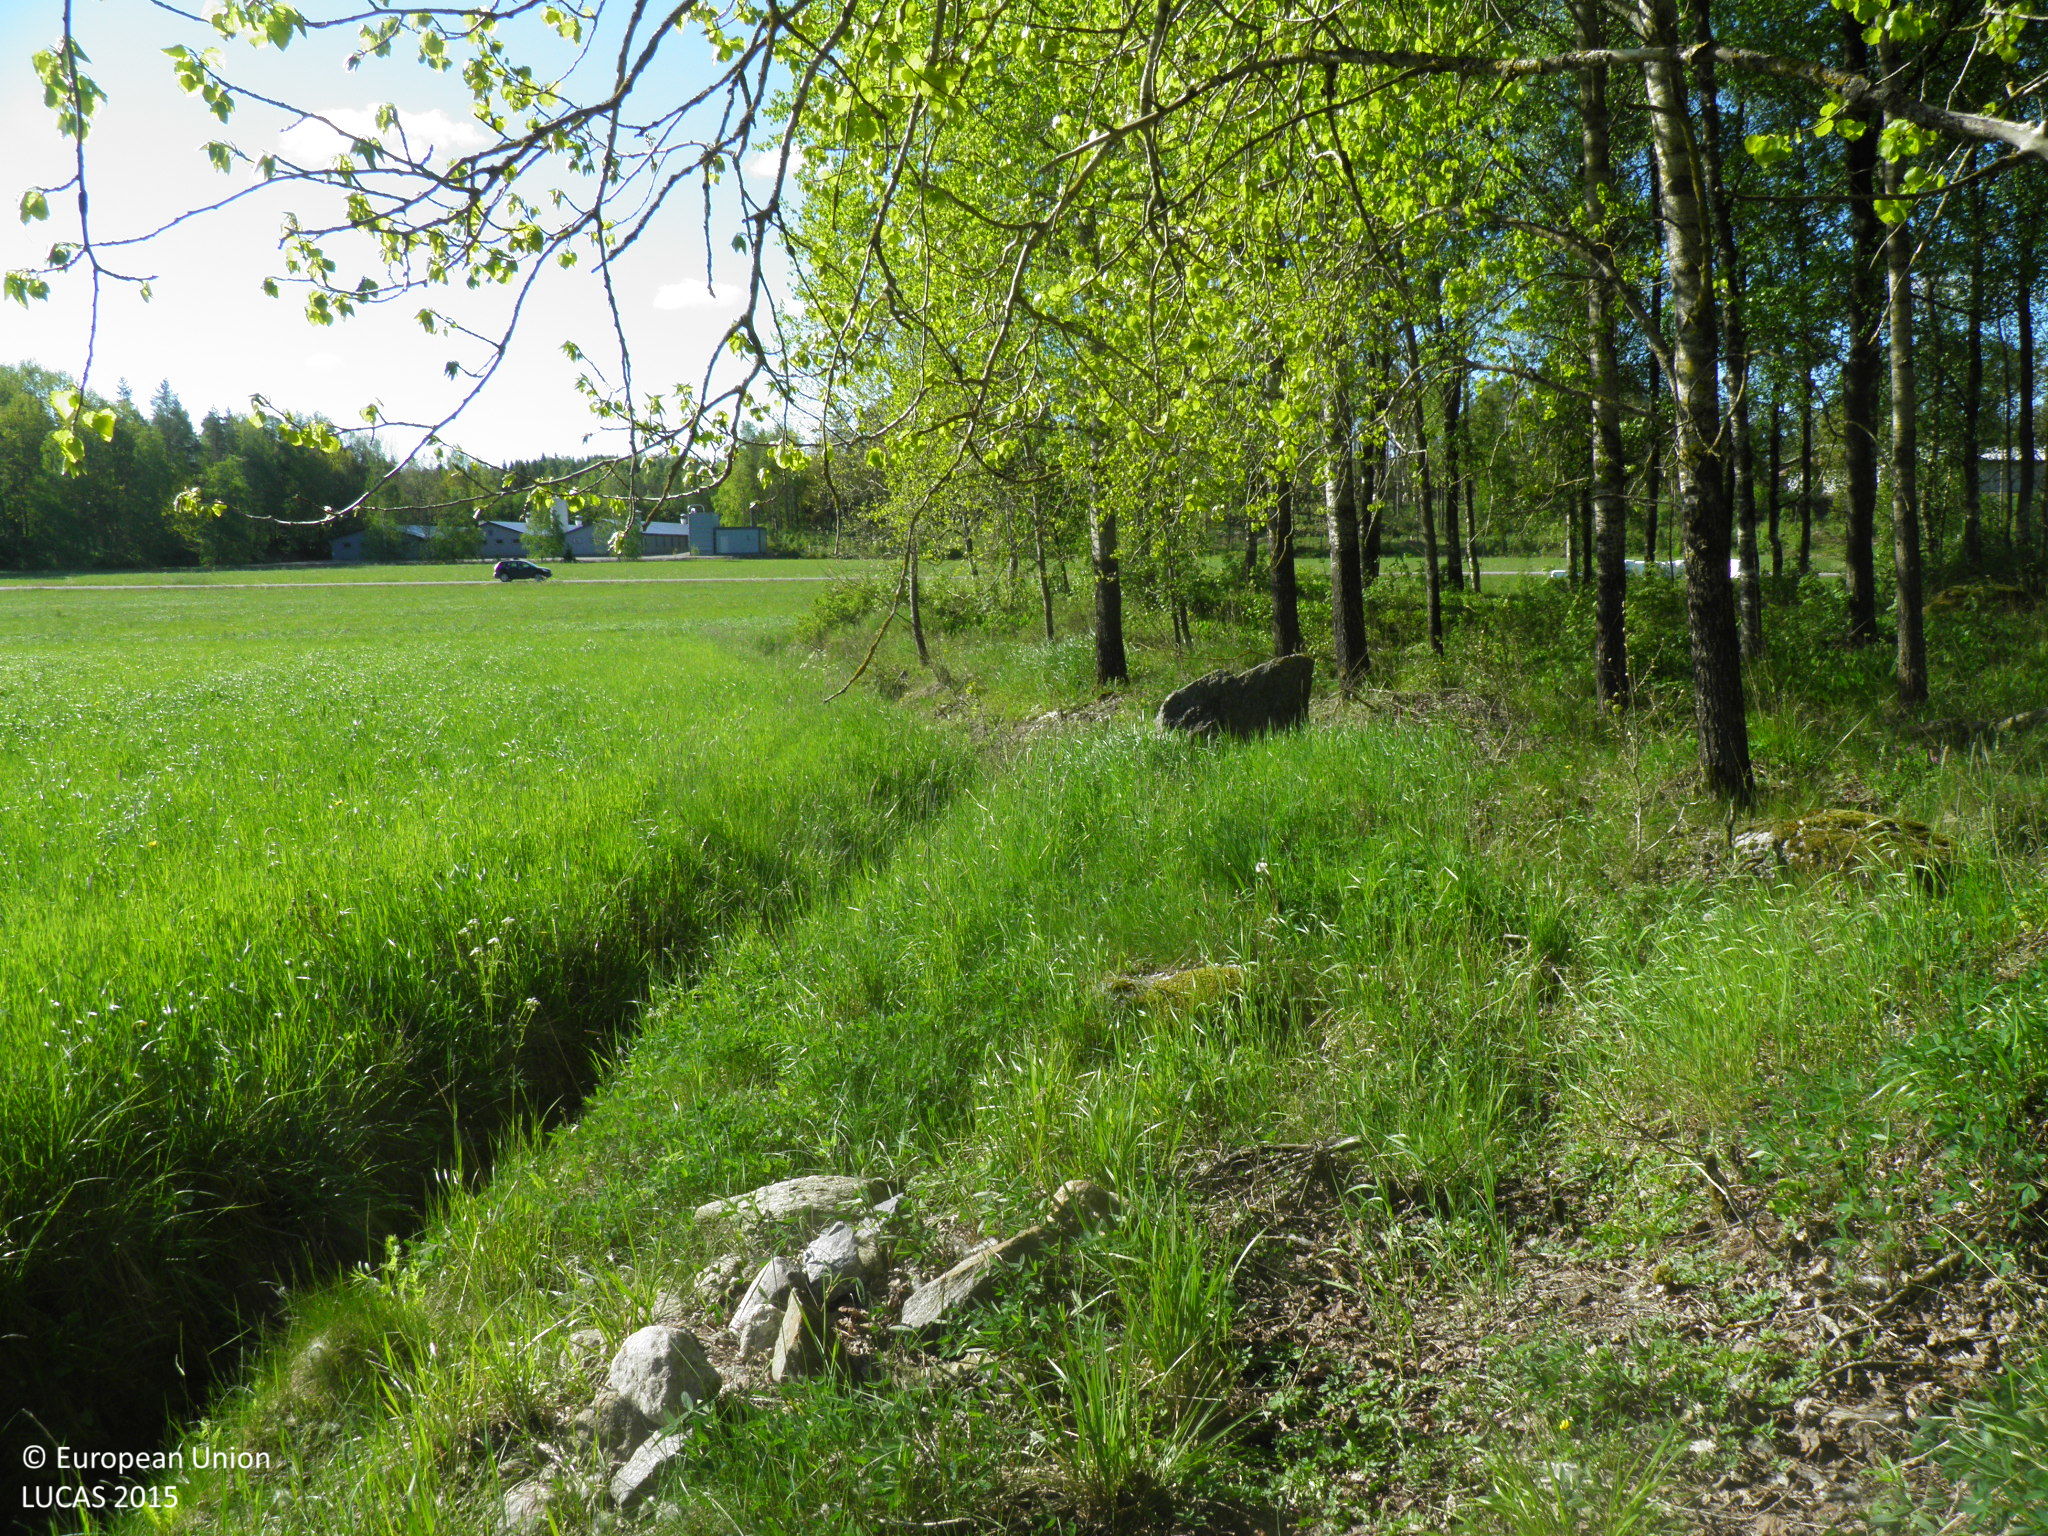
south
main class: Woodland
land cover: Broadleaved woodland
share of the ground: > 75 %
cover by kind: broadleaved forest trees 90 %, herbaceous plants 5 %, lichens and mosses 5 %
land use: Semi-natural and natural areas not in use
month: June
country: FI
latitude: 60.5825
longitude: 22.1659
